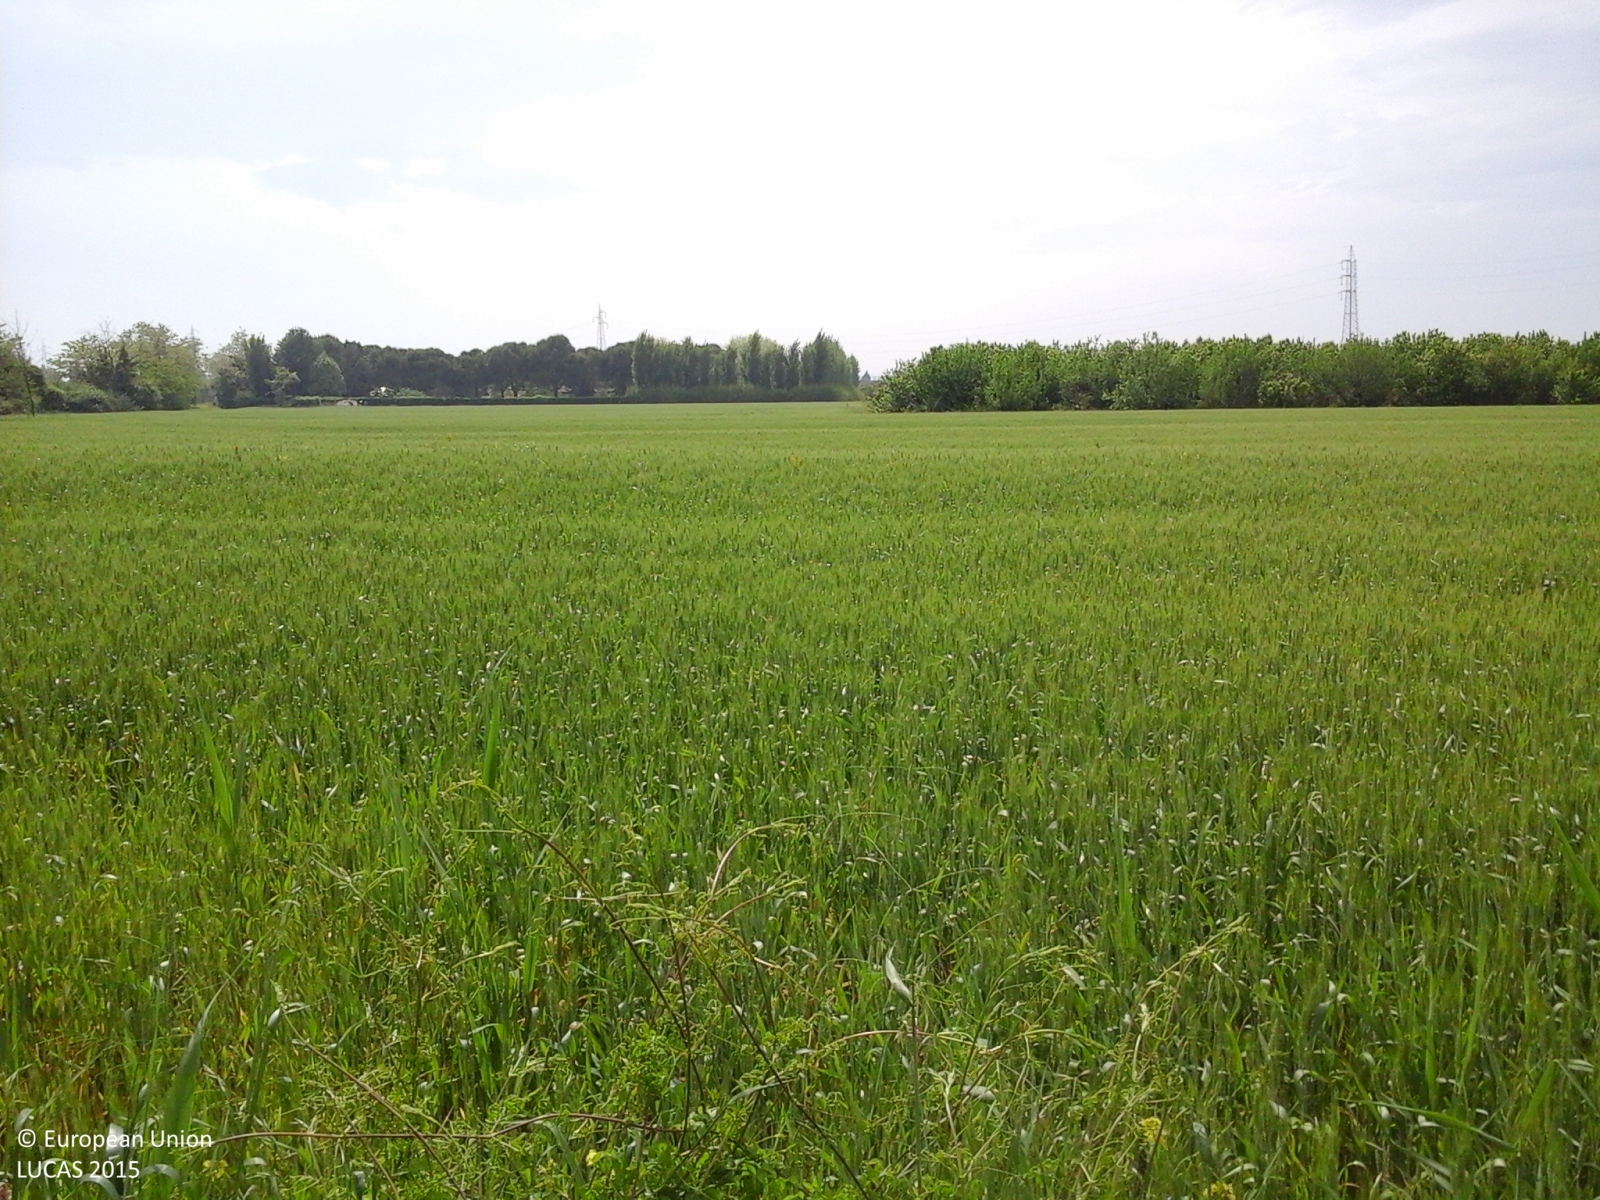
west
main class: Cropland
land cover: Common wheat
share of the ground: > 75 %
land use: Agriculture (excluding fallow land and kitchen gardens)
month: May
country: IT
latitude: 44.0677
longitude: 12.5038
